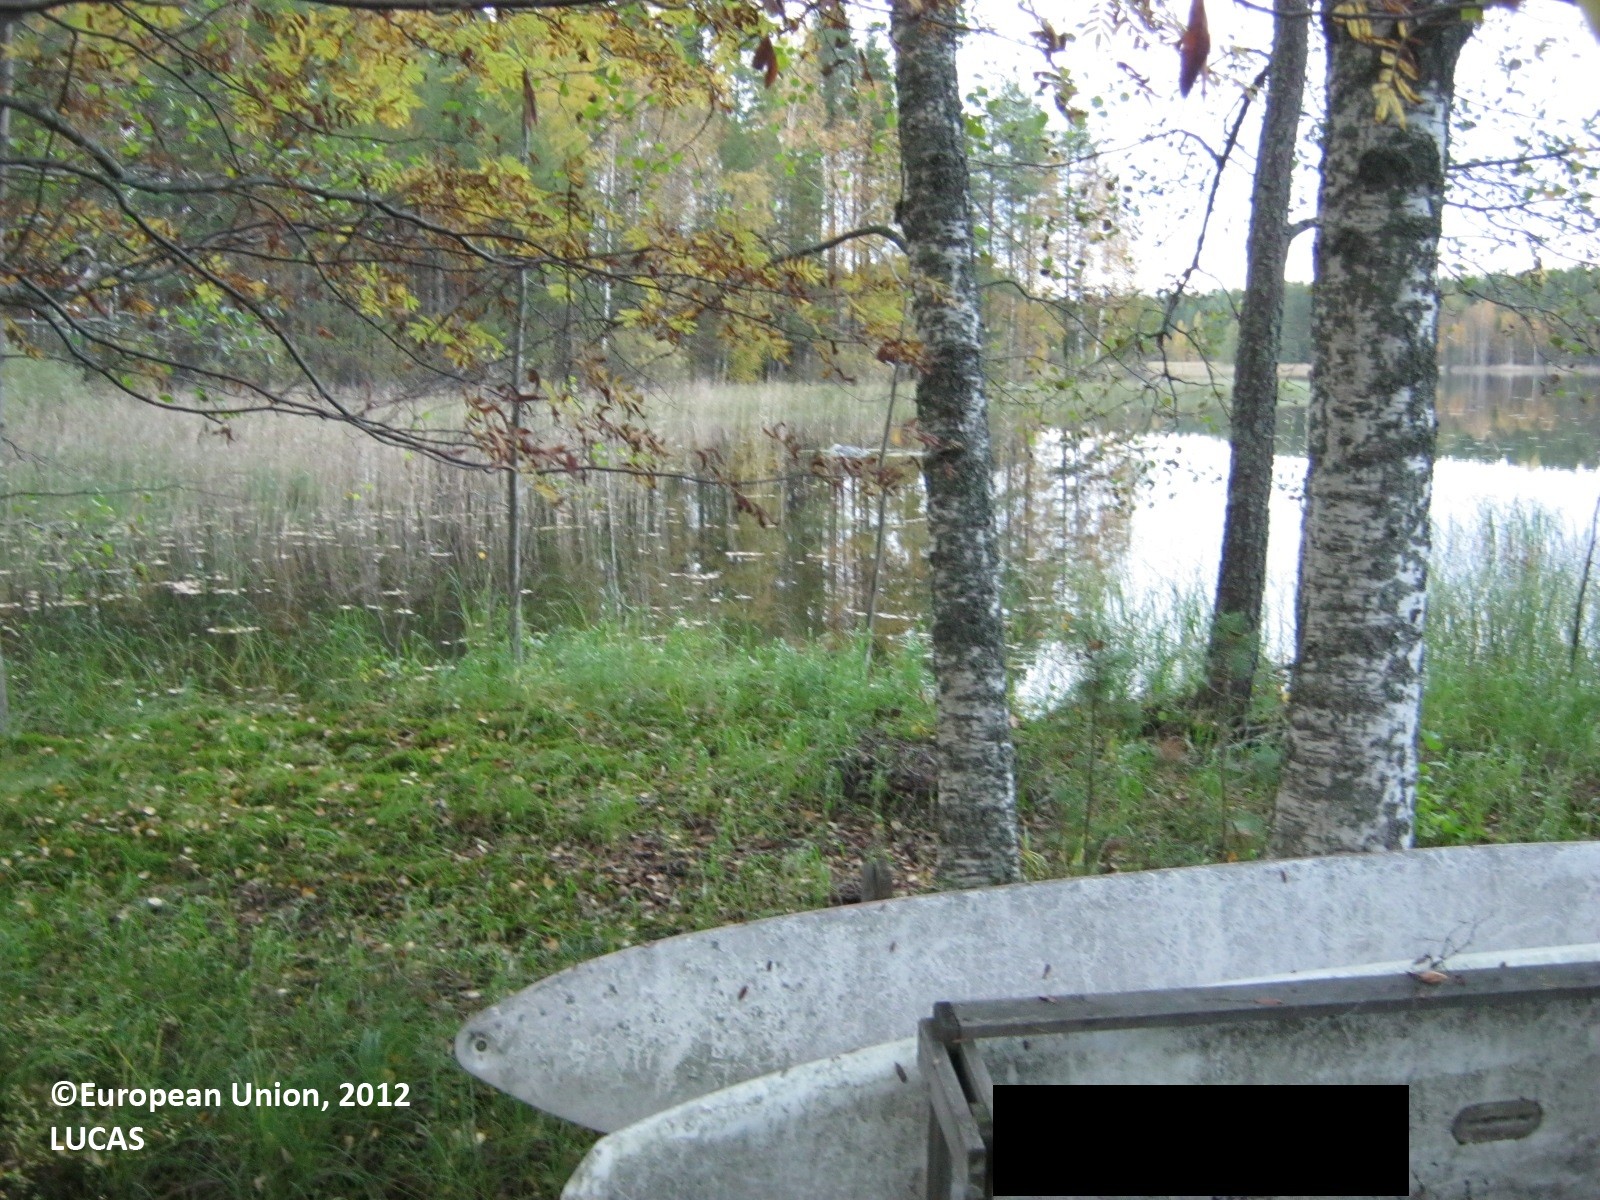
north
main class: Woodland
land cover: Other mixed woodland
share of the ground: 25 - 50 %
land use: Residential
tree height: > 5 m
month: September
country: FI
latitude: 62.3283
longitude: 28.7617
